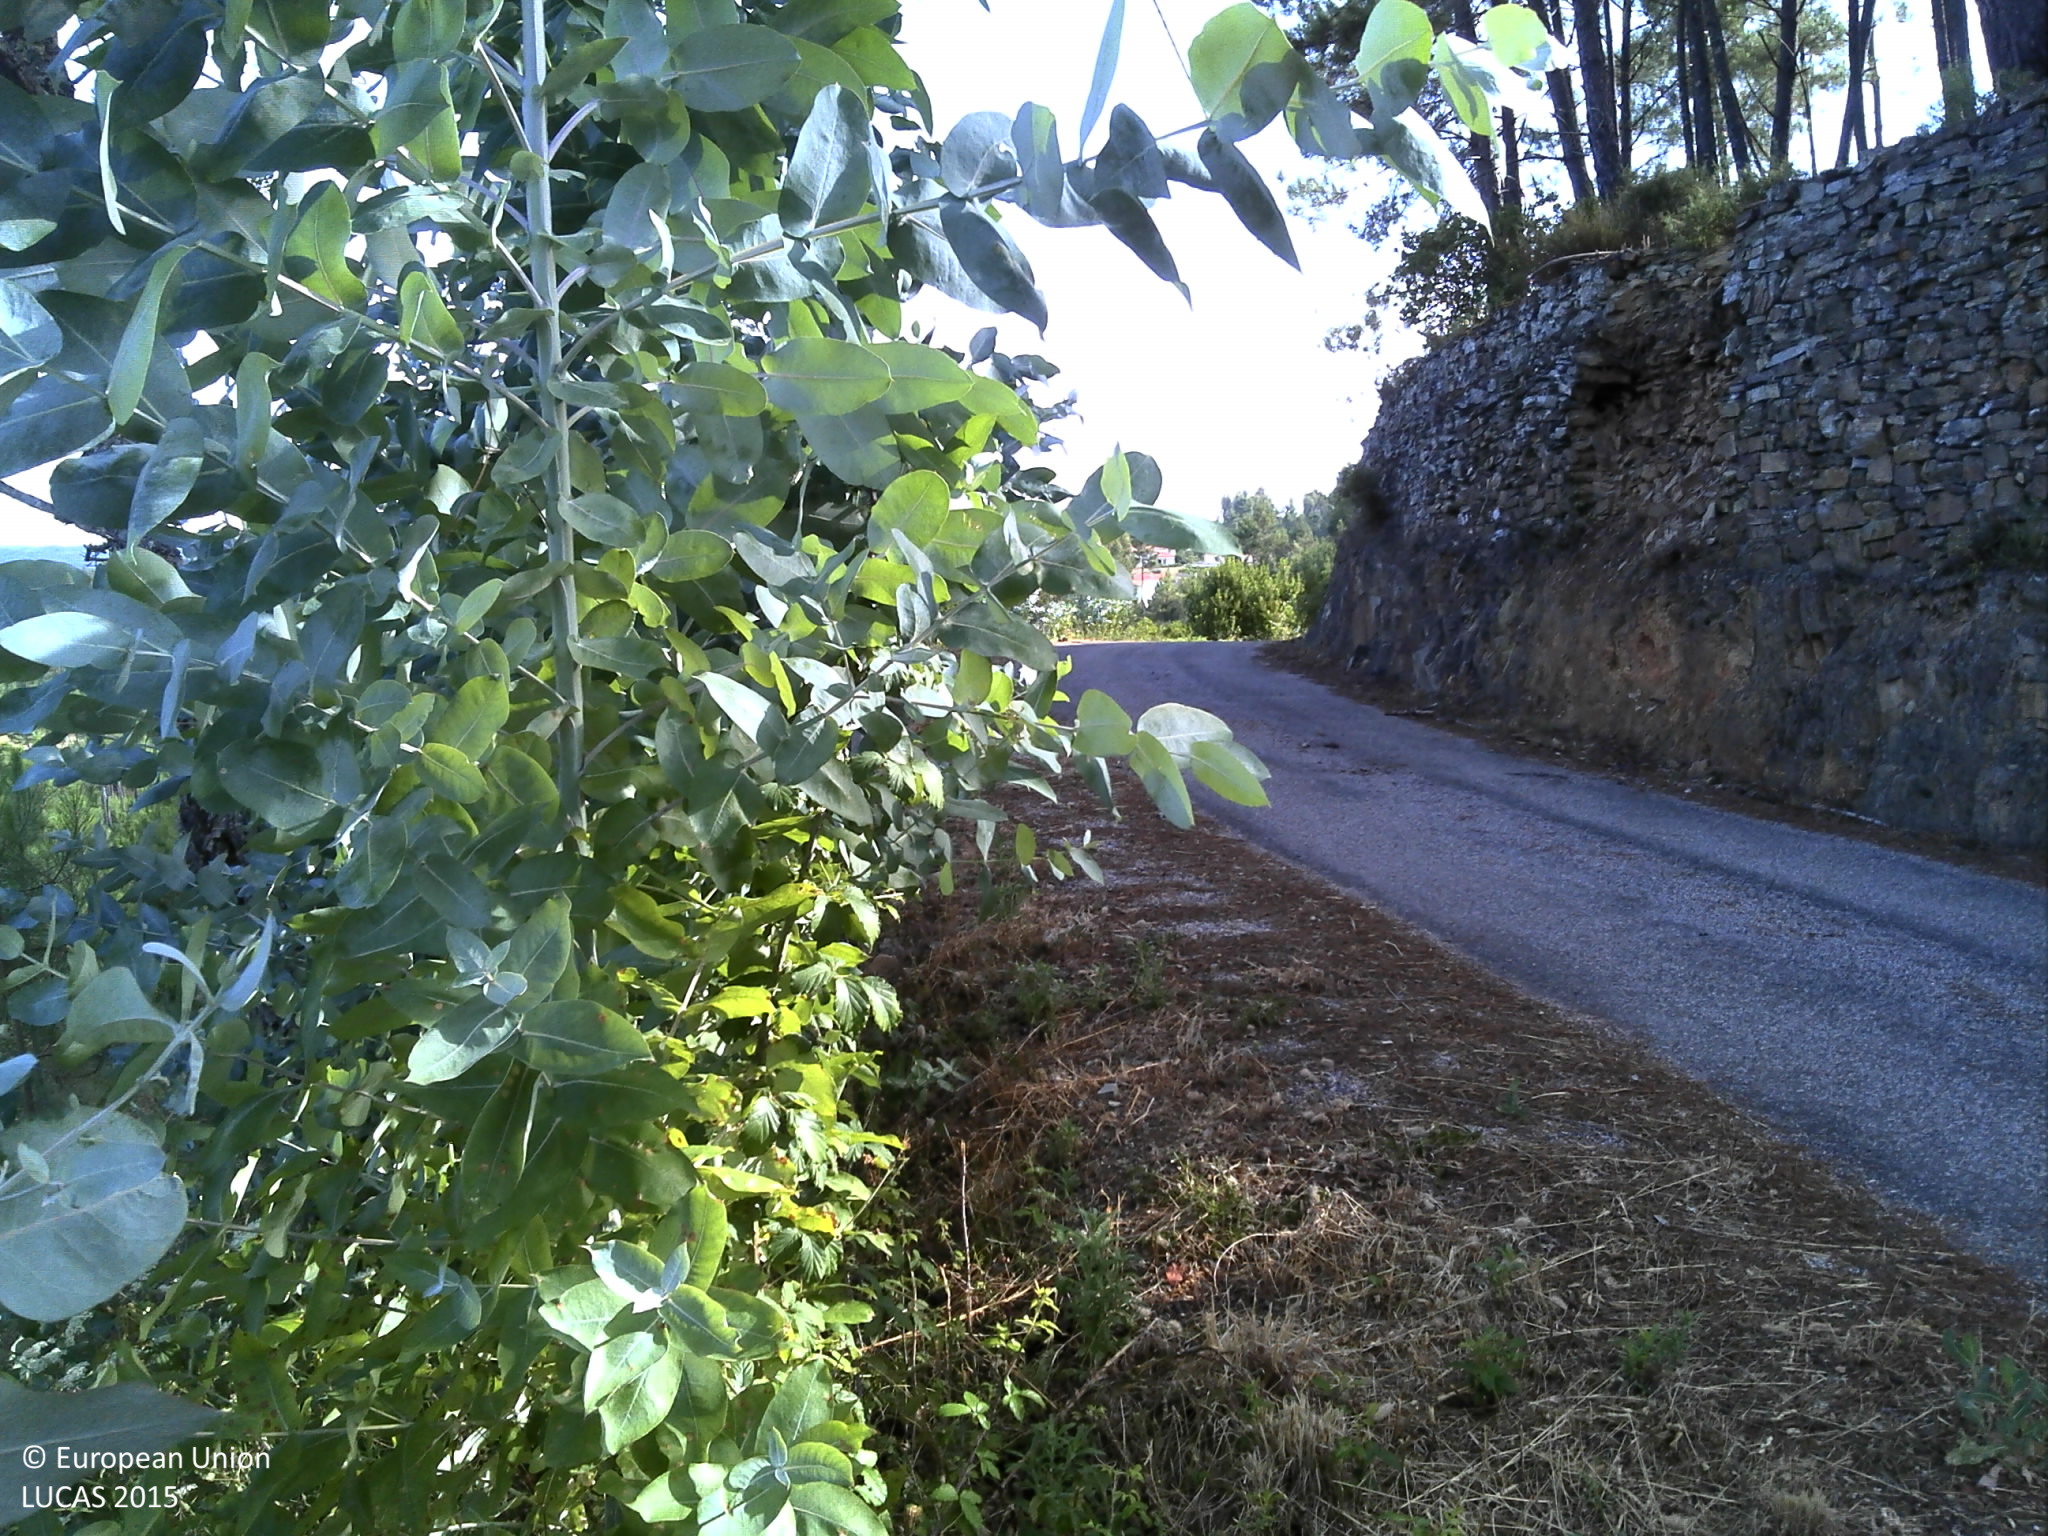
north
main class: Woodland
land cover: Broadleaved woodland
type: exotic forest
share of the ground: < 10 %
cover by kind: shrubs 90 %, broadleaved forest trees 10 %
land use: Forestry
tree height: < 5 m
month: July
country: PT
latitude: 39.8253
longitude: -7.9994
